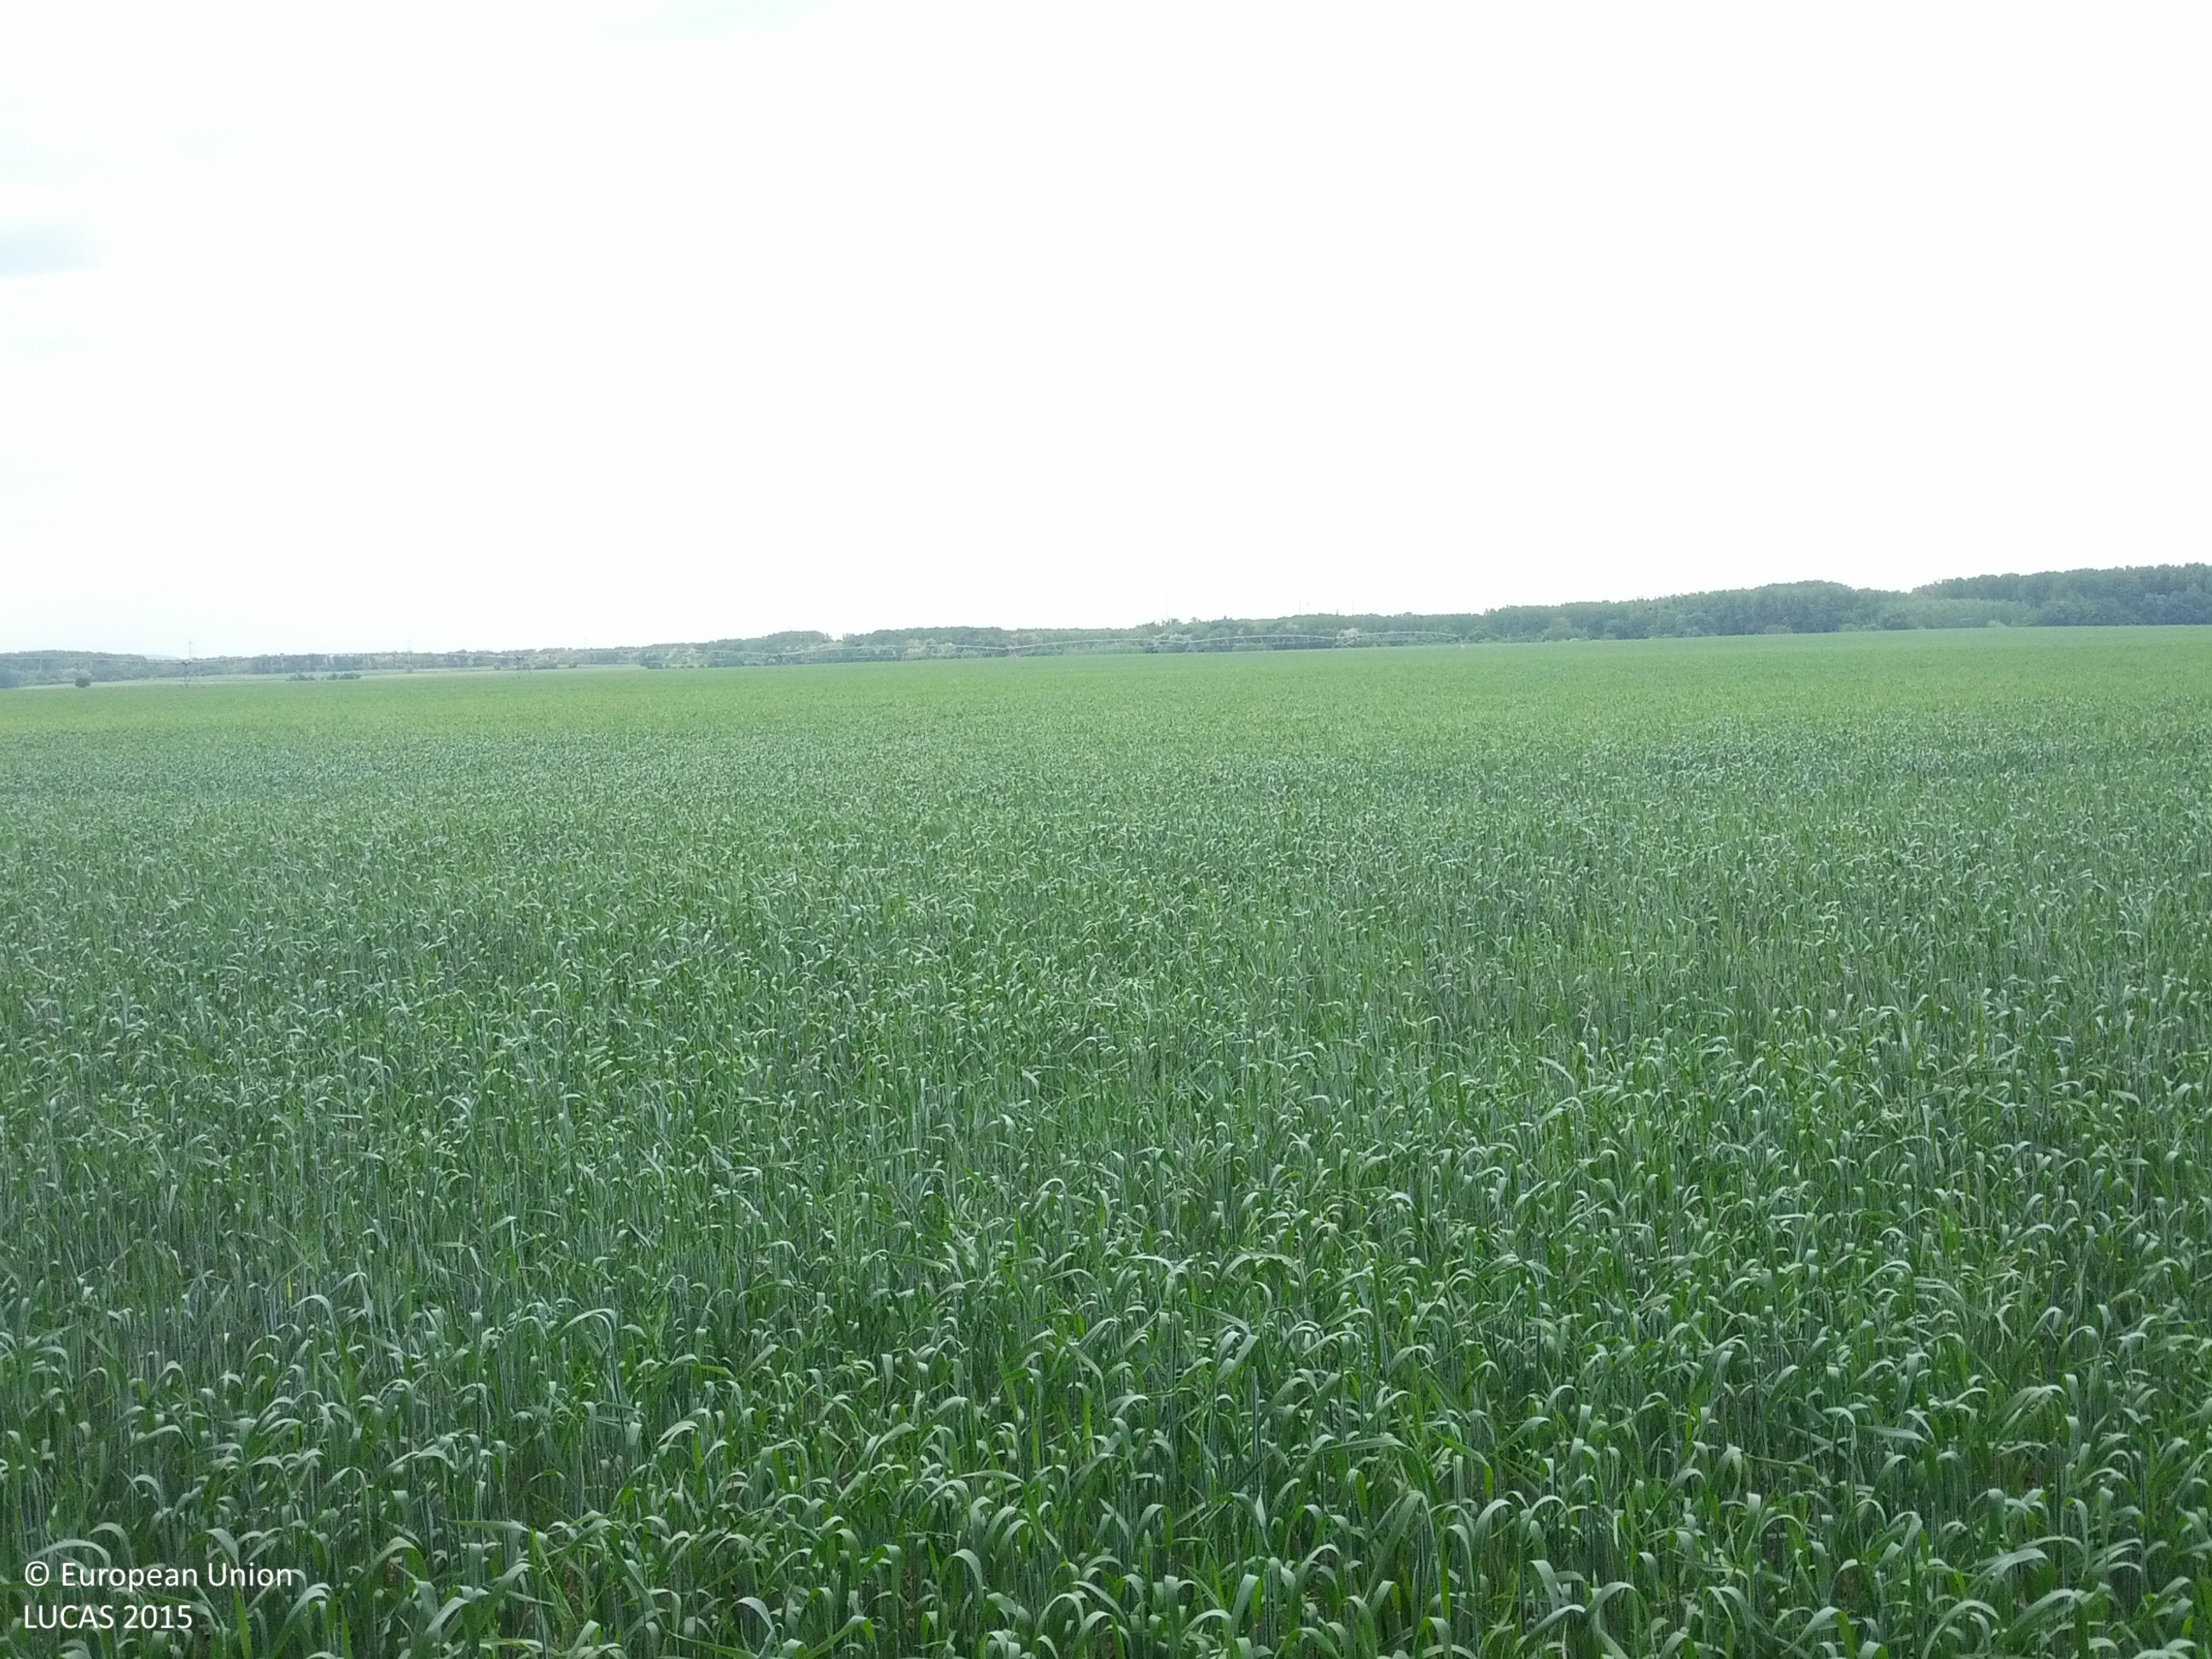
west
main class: Cropland
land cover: Common wheat
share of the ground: > 75 %
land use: Agriculture (excluding fallow land and kitchen gardens)
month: May
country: AT
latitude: 48.0458
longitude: 16.8614
